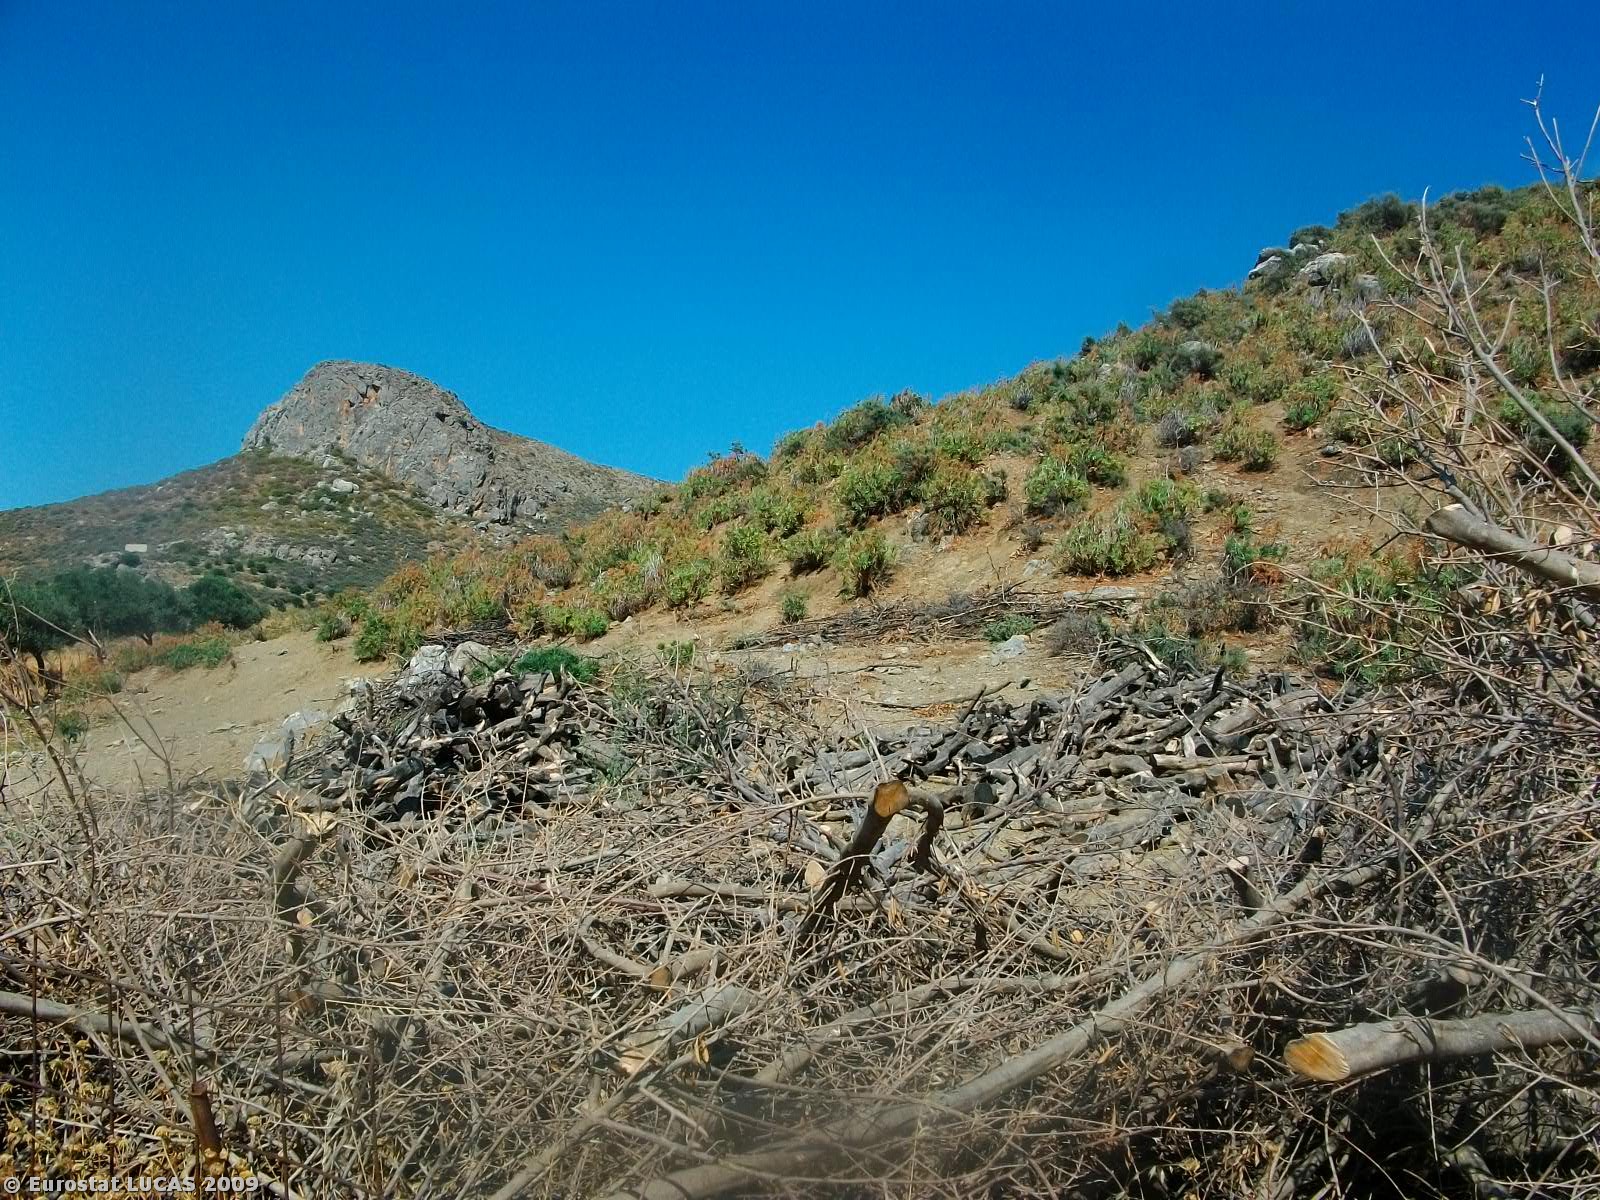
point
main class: Shrubland
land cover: Shrubland with sparse tree cover
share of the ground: > 75 %
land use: Unused
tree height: < 5 m
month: June
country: GR
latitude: 35.0046
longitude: 24.8749
